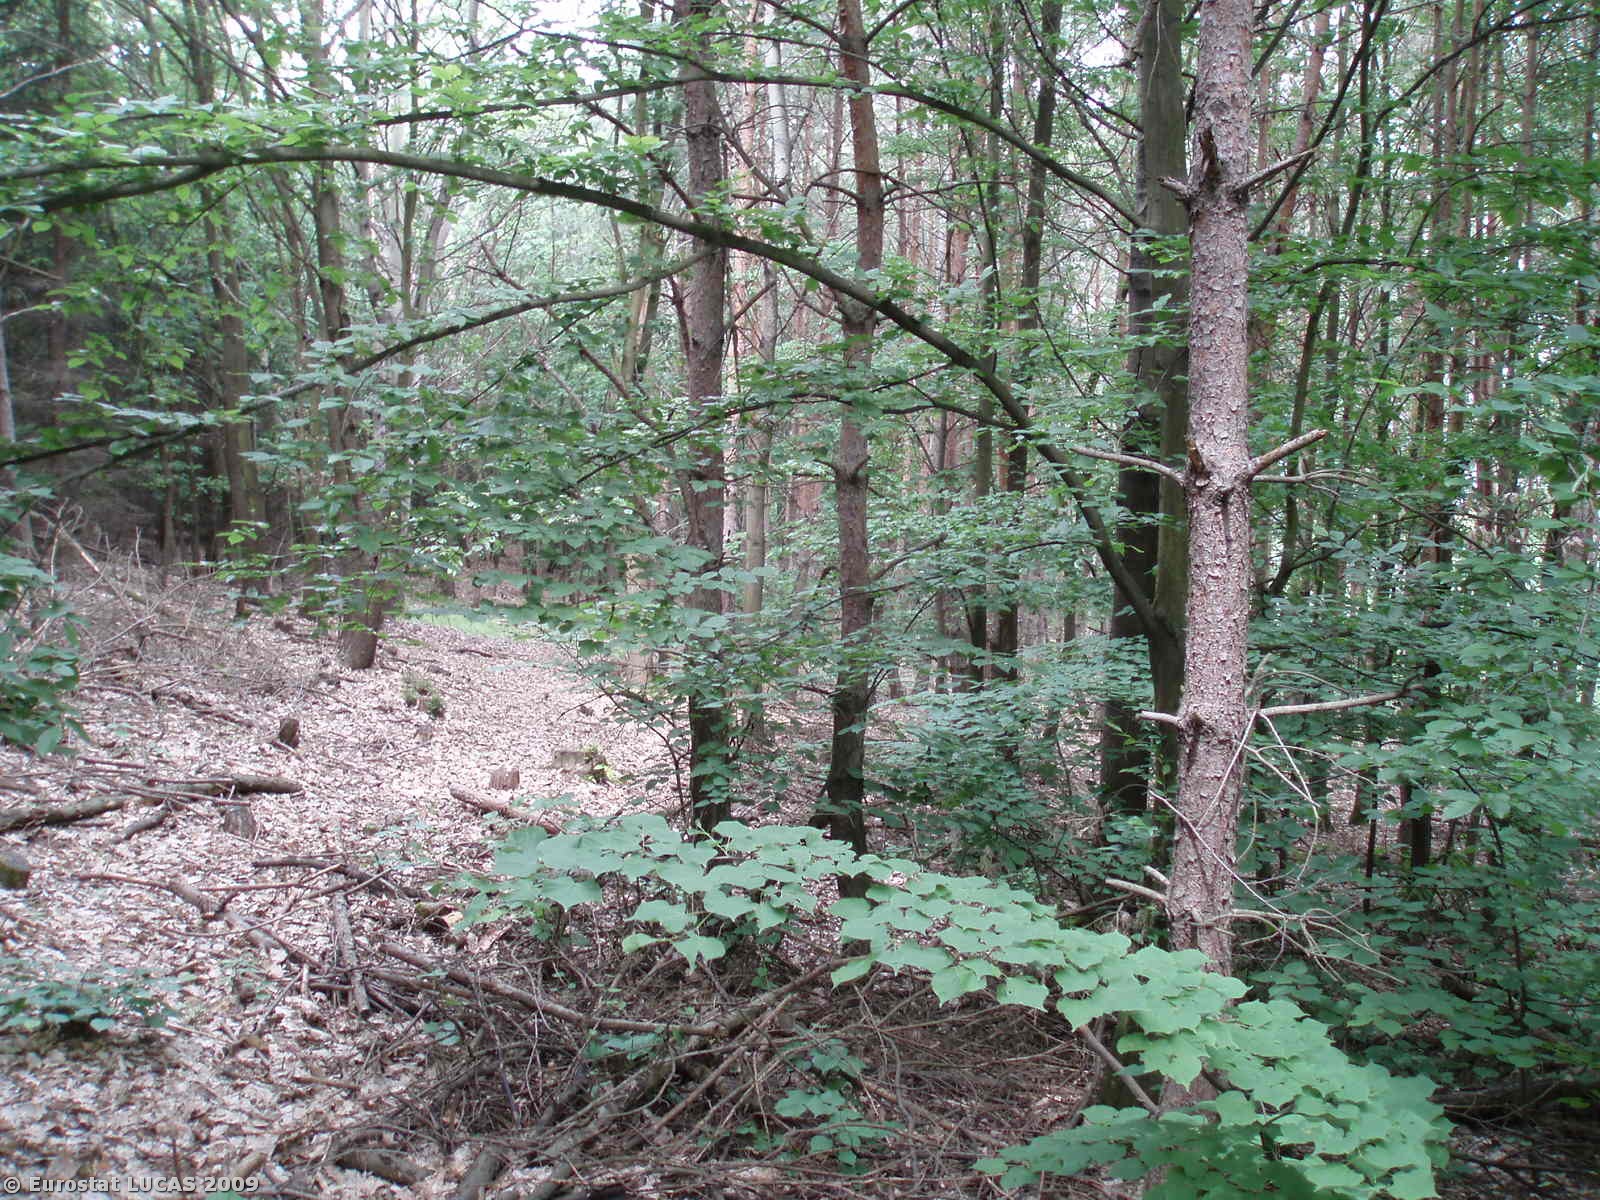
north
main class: Woodland
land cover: Mixed woodland
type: hemiboreal forest and nemoral coniferous forest and mixed broadleaved-coniferous forest
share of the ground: > 75 %
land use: Forestry
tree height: > 5 m
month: May
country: CZ
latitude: 50.2601
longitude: 13.9425
